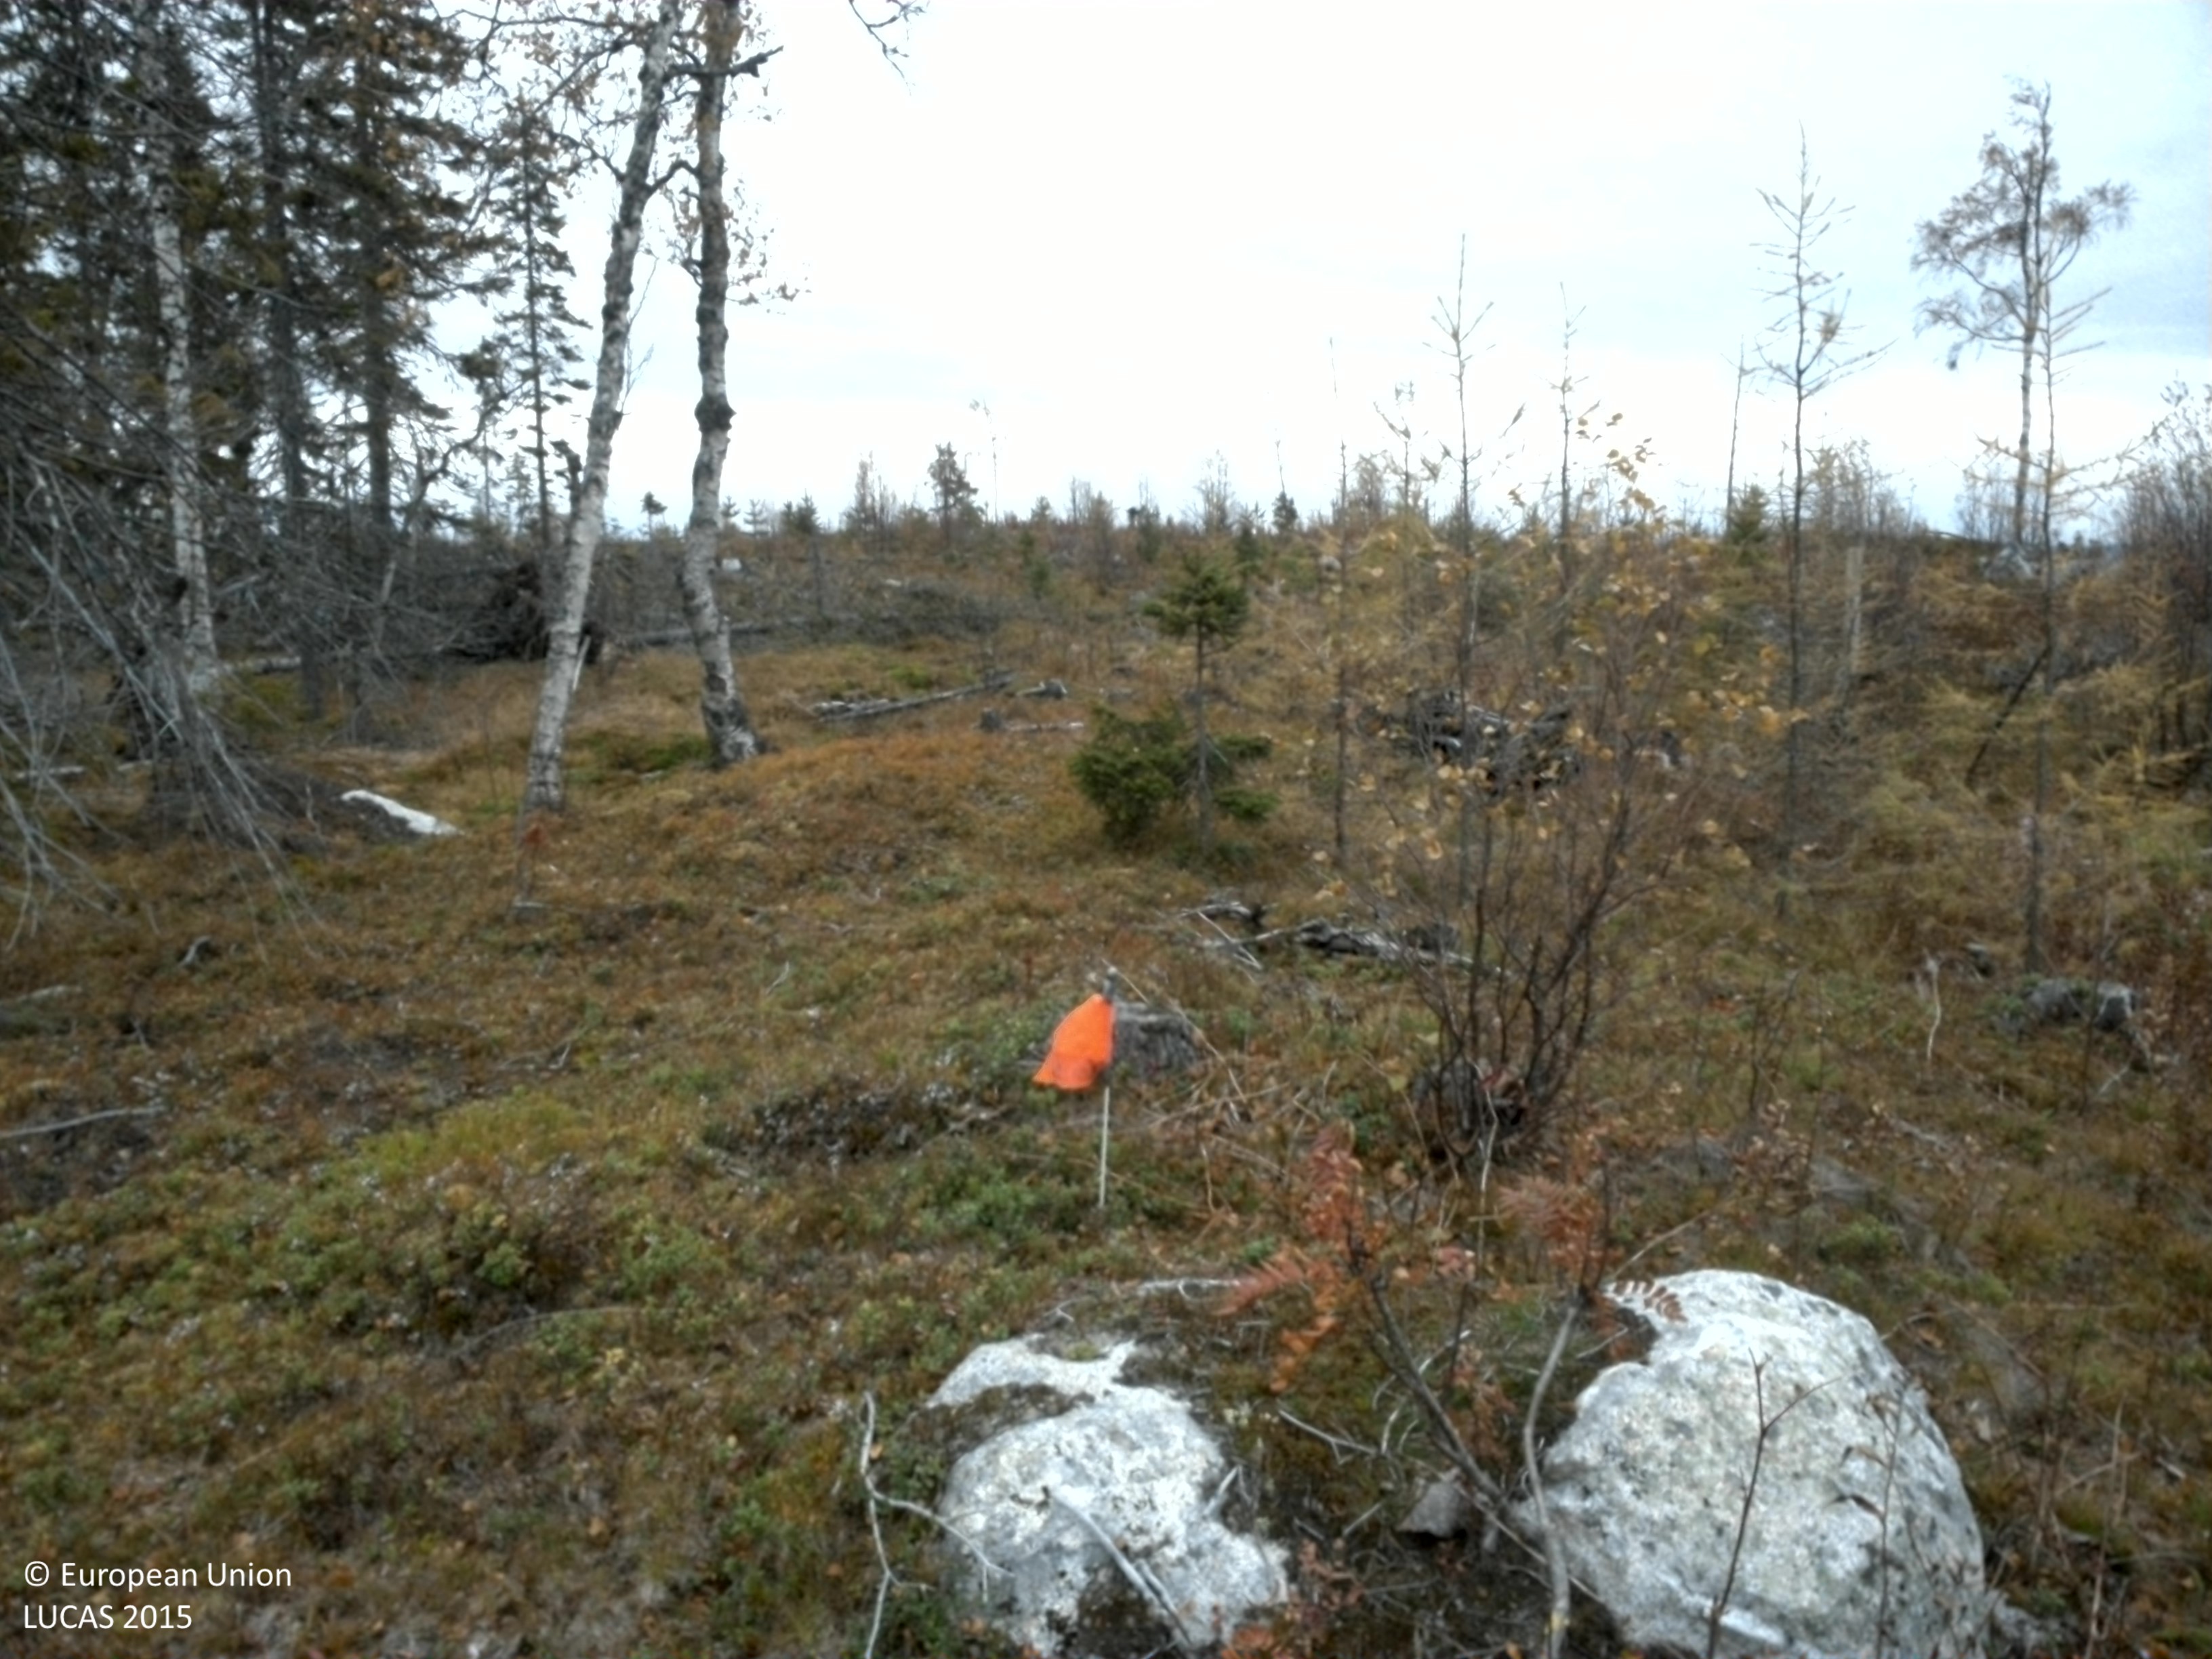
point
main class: Woodland
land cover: Other mixed woodland
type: exotic forest
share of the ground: 10 - 25 %
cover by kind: herbaceous plants 55 %, shrubs 20 %, lichens and mosses 15 %, coniferous forest trees 5 %, broadleaved forest trees 5 %
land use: Forestry
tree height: < 5 m
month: October
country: SE
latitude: 64.9560
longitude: 16.8876
